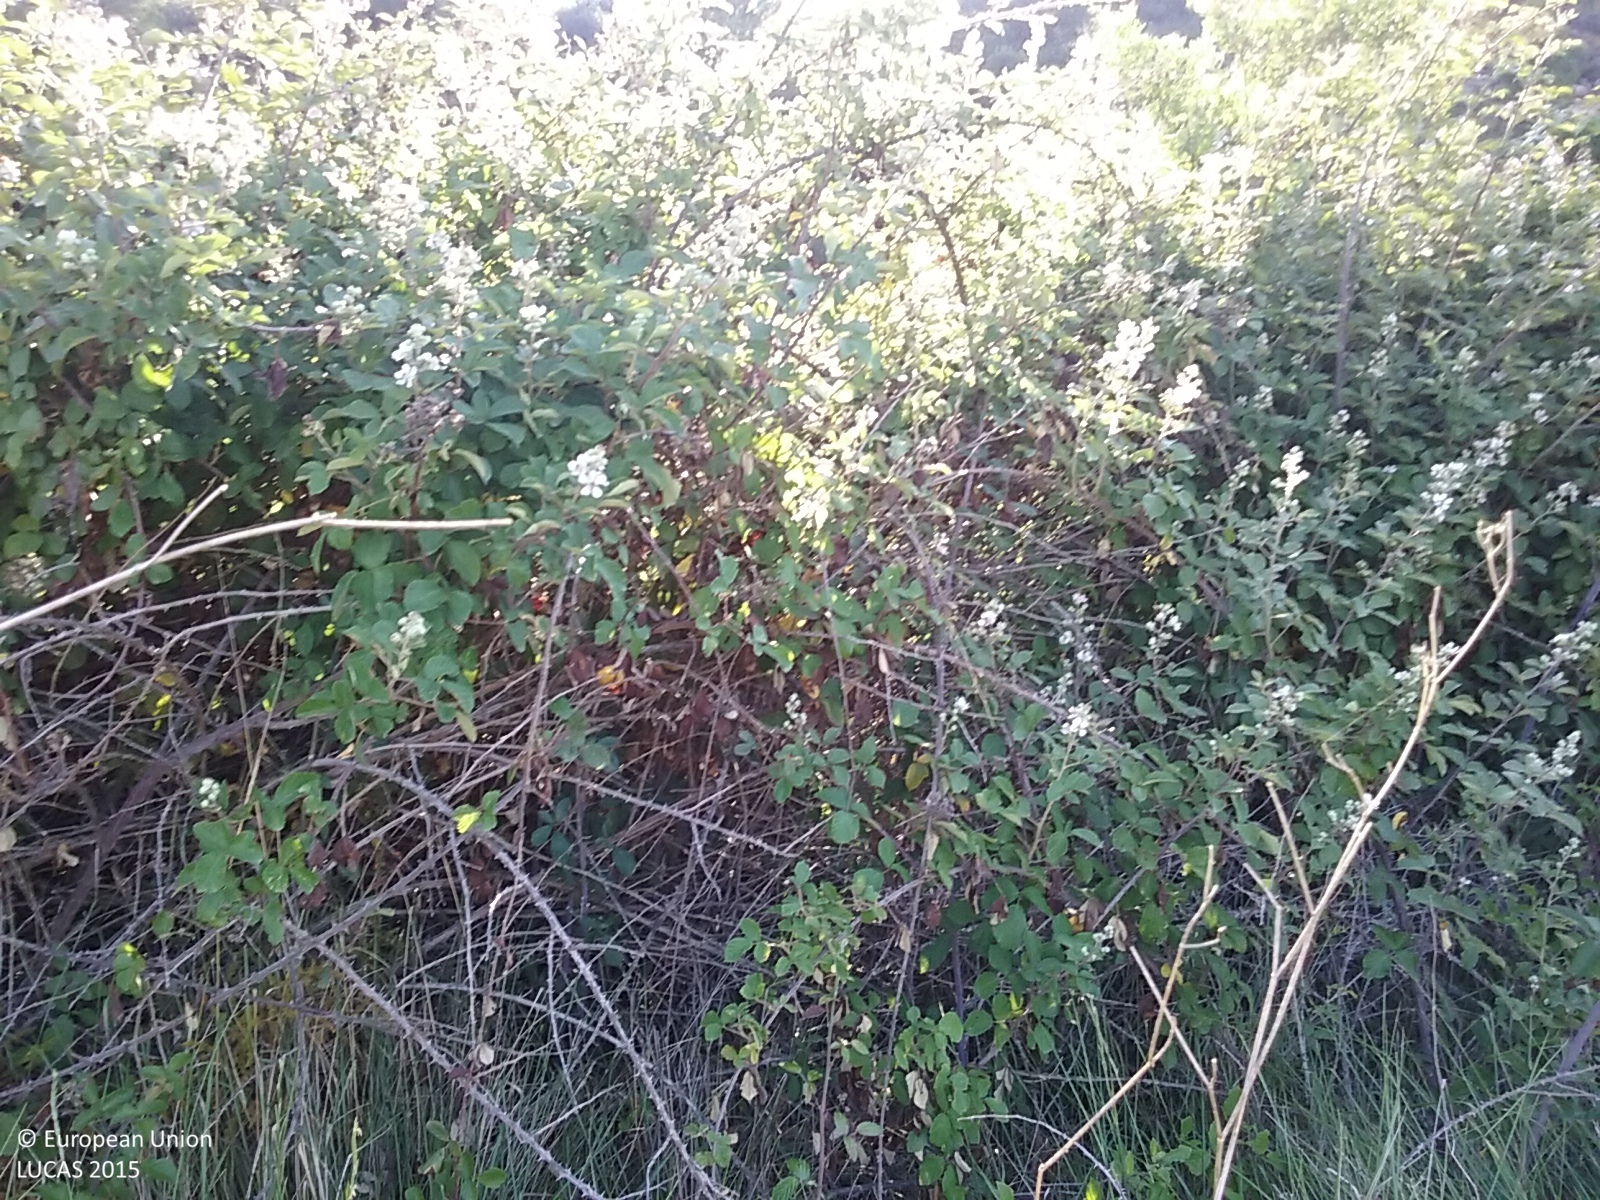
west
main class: Woodland
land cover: Pine dominated coniferous woodland
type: coniferous forest of the mediterranean region
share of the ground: 50 - 75 %
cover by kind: coniferous forest trees 60 %, shrubs 40 %
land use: Semi-natural and natural areas not in use
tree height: > 5 m
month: June
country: ES
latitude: 41.1759
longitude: 0.3705
